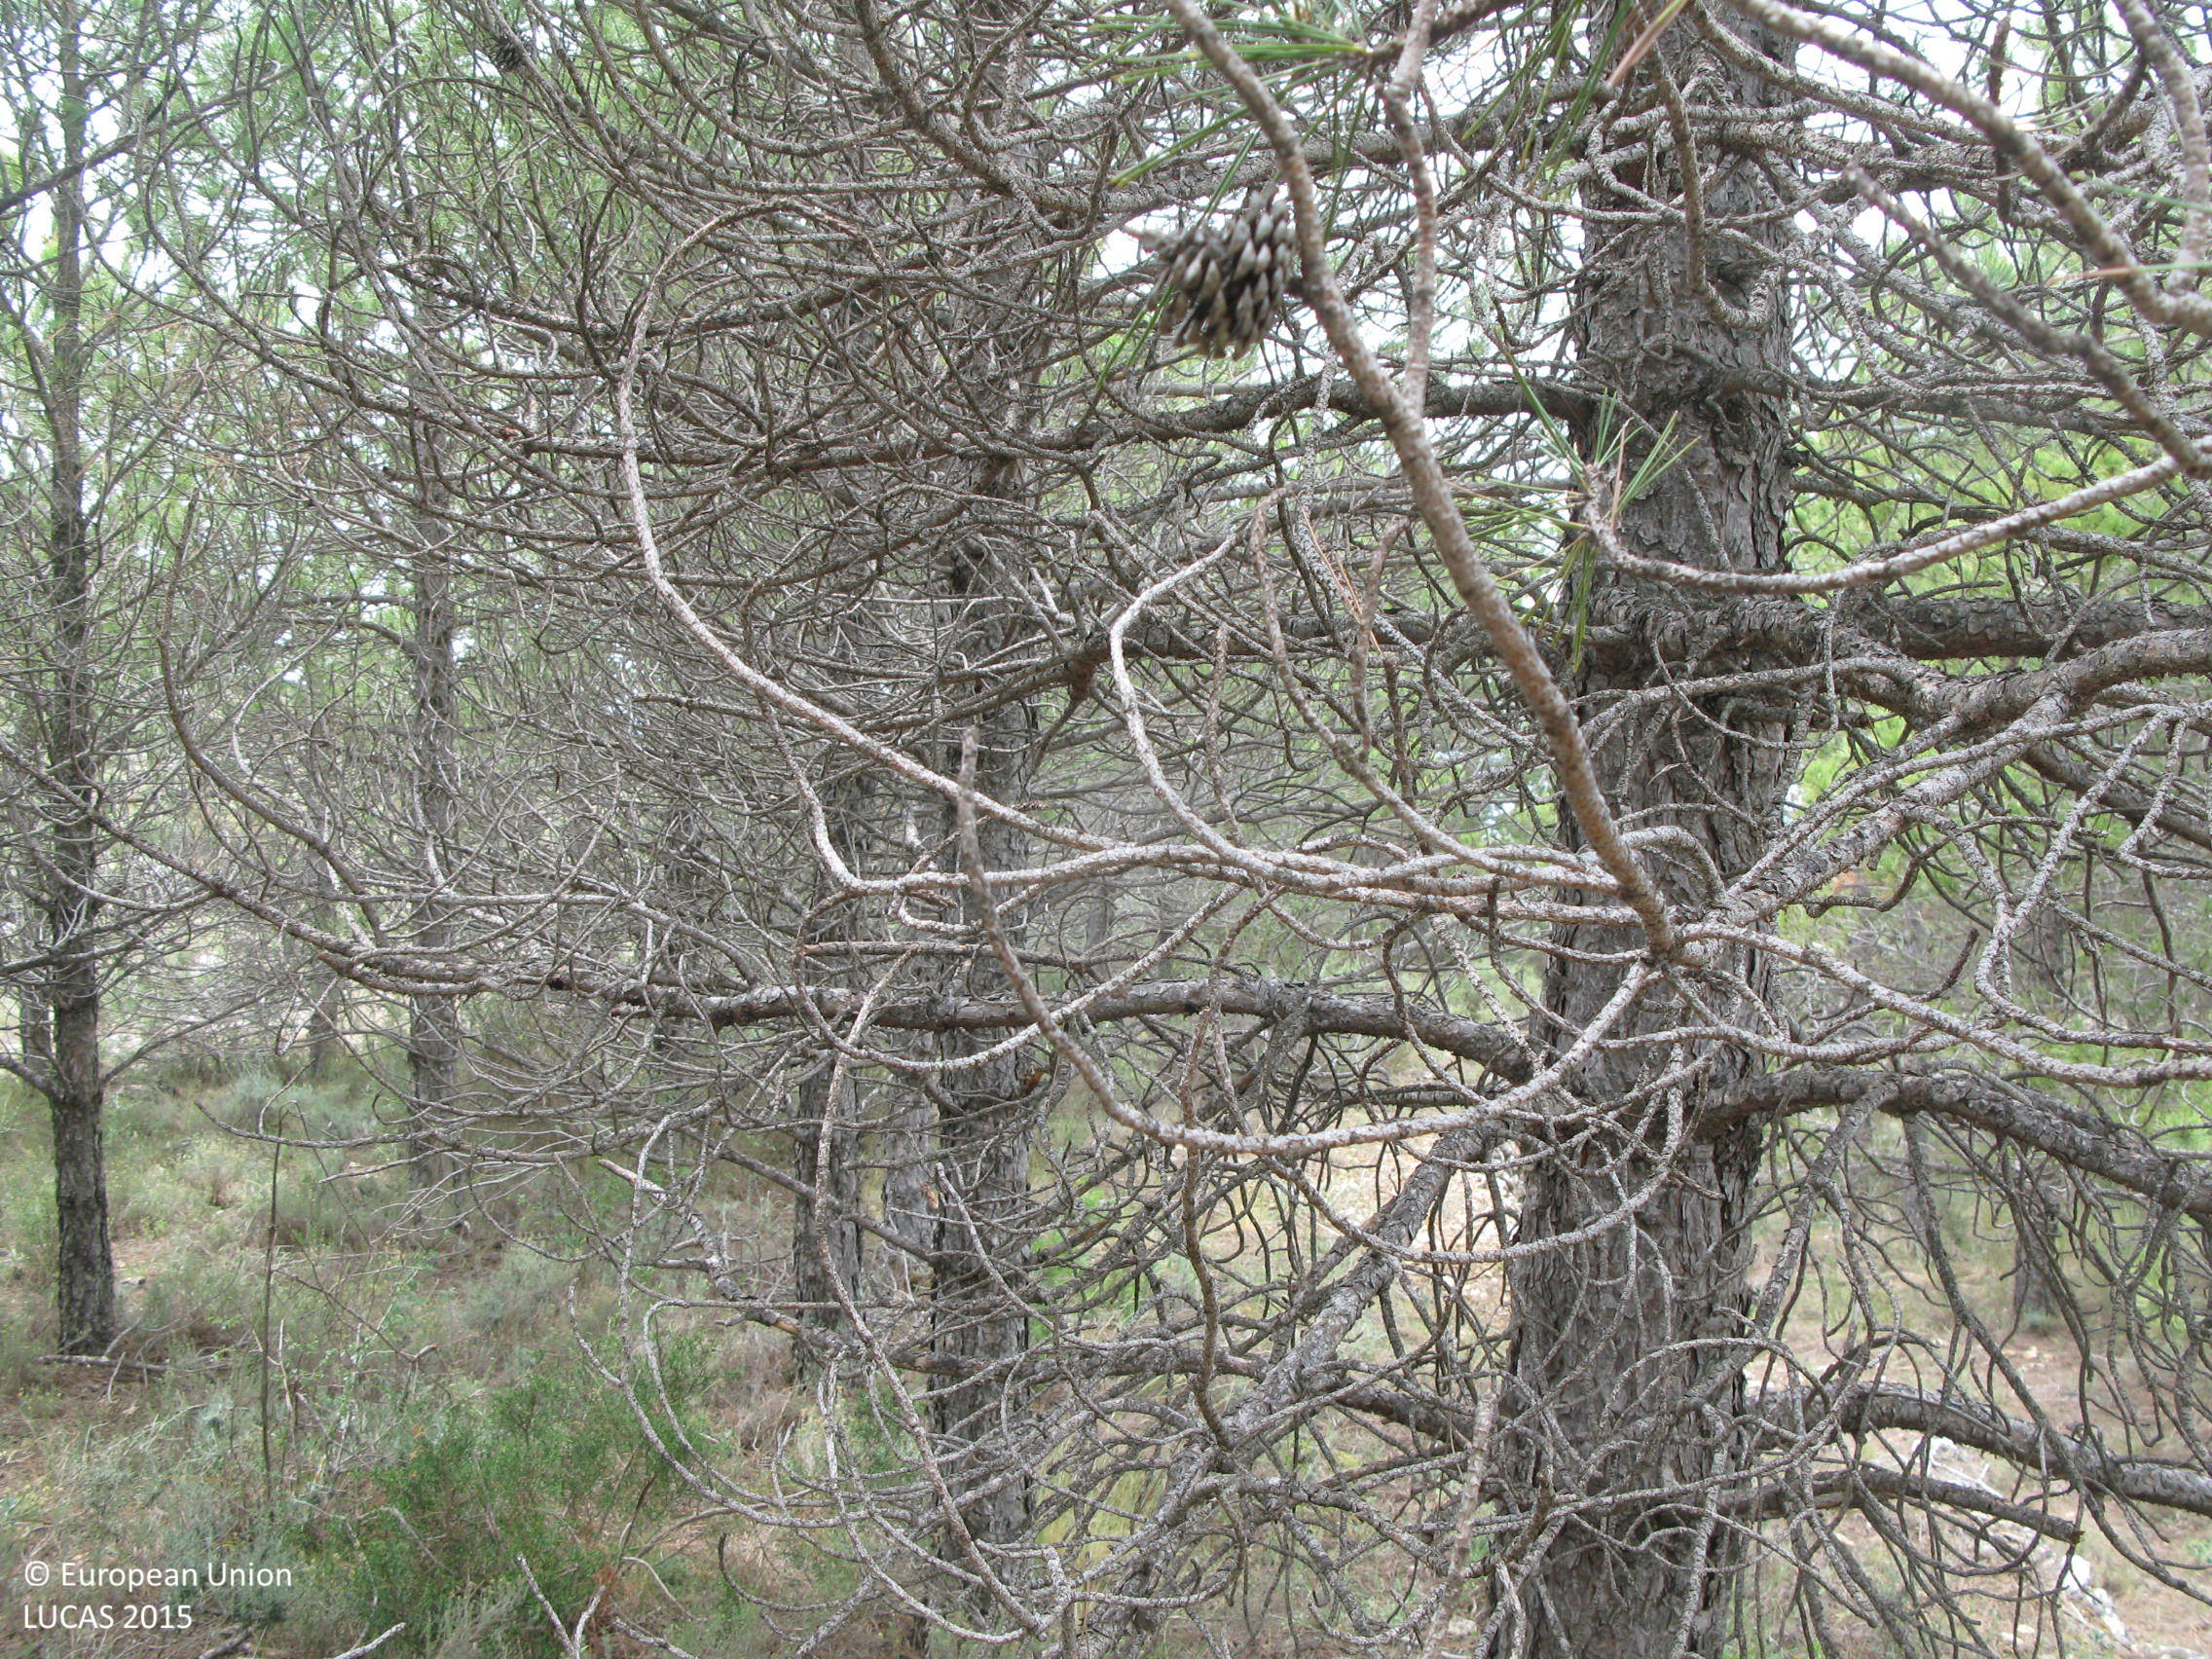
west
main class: Woodland
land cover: Pine dominated coniferous woodland
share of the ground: > 75 %
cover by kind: coniferous forest trees 80 %, herbaceous plants 20 %
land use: Forestry
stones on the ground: 10 - 25 %
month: June
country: ES
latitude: 40.0408
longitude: -1.2245
